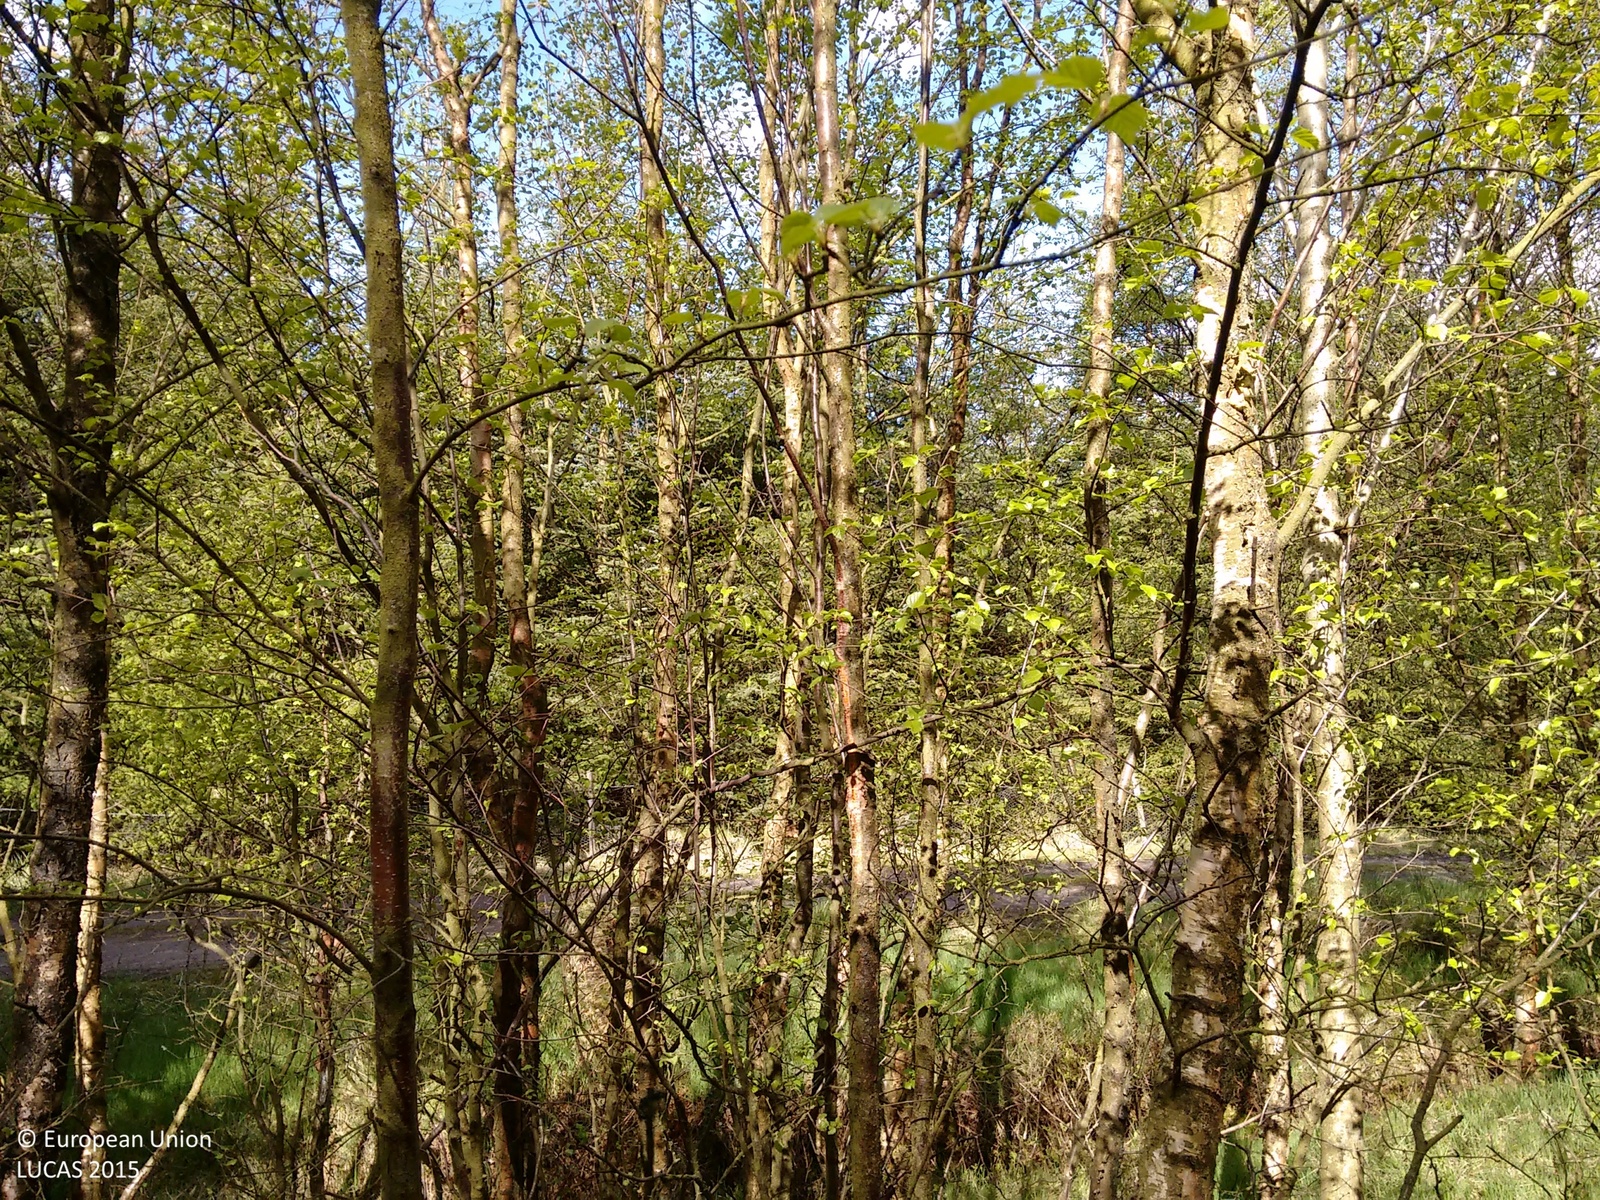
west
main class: Woodland
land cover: Broadleaved woodland
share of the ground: > 75 %
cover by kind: broadleaved forest trees 100 %
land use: Forestry
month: May
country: GB
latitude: 56.1908
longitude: -3.9272
